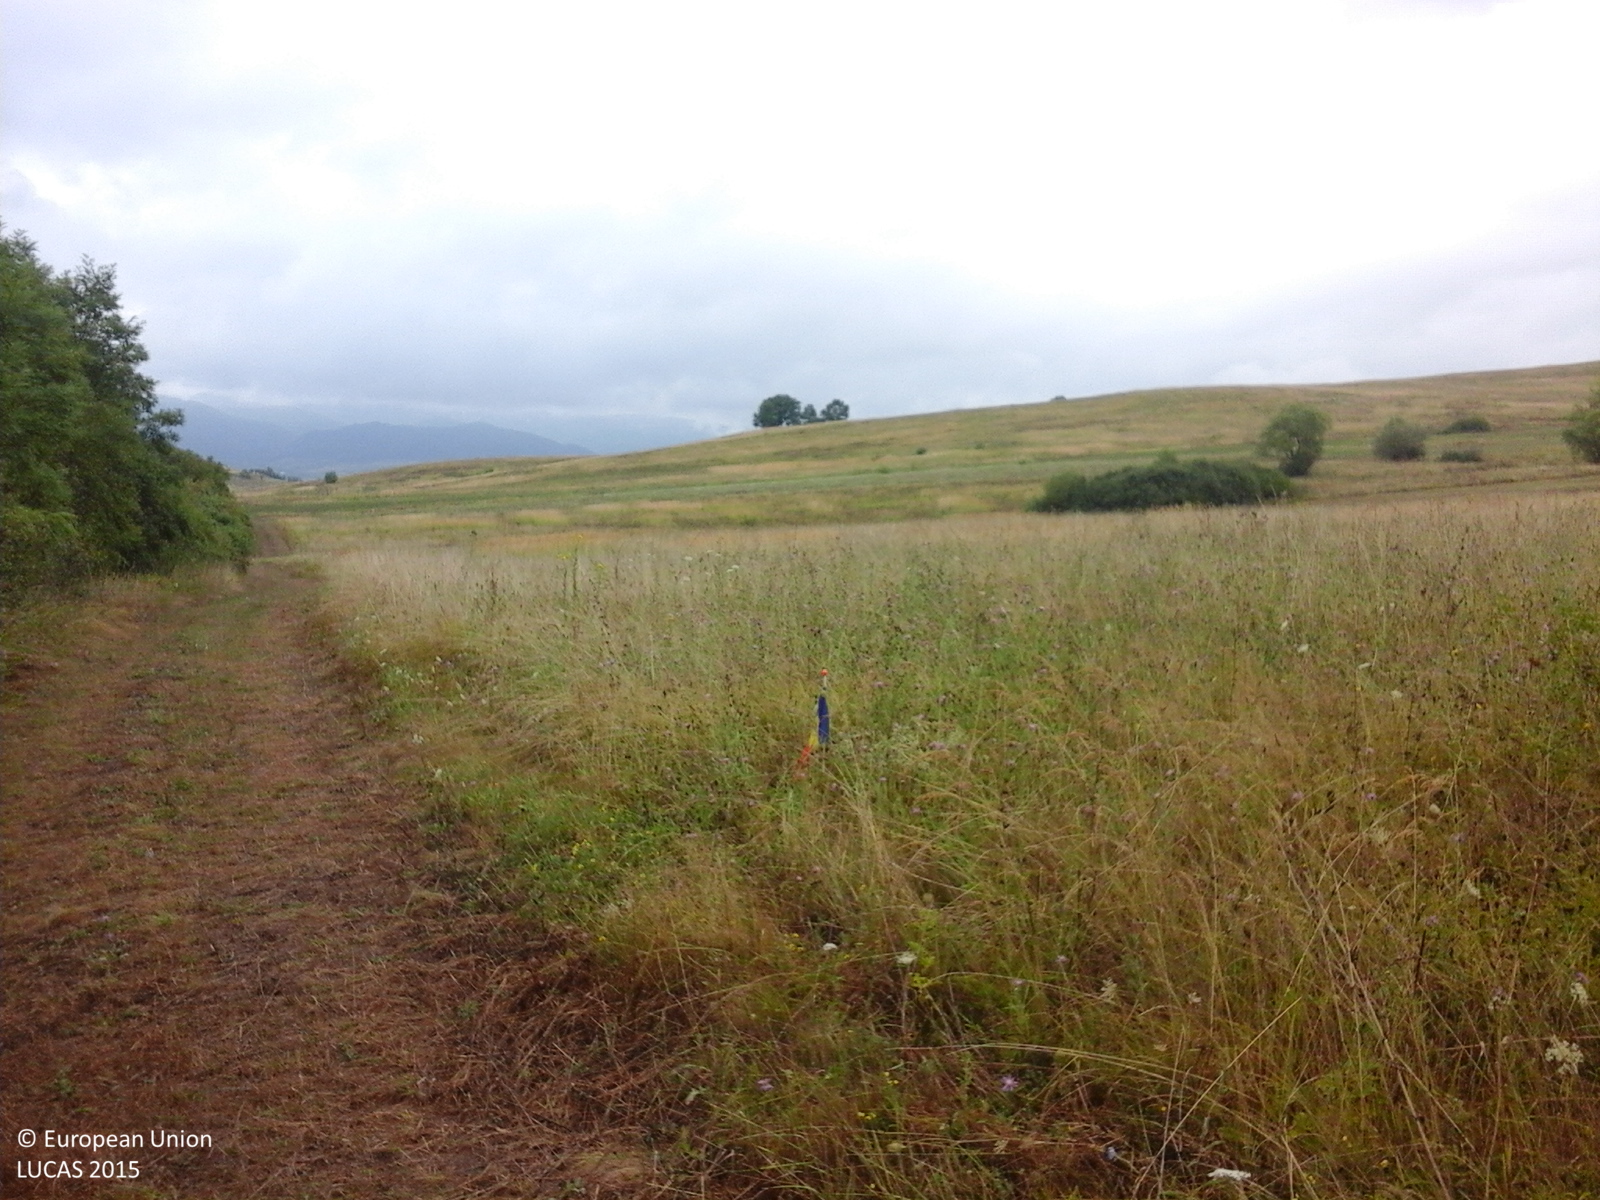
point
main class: Grassland
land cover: Grassland without tree/shrub cover
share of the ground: > 75 %
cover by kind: herbaceous plants 100 %
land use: Agriculture (excluding fallow land and kitchen gardens)
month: August
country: RO
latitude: 44.8694
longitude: 22.0210
